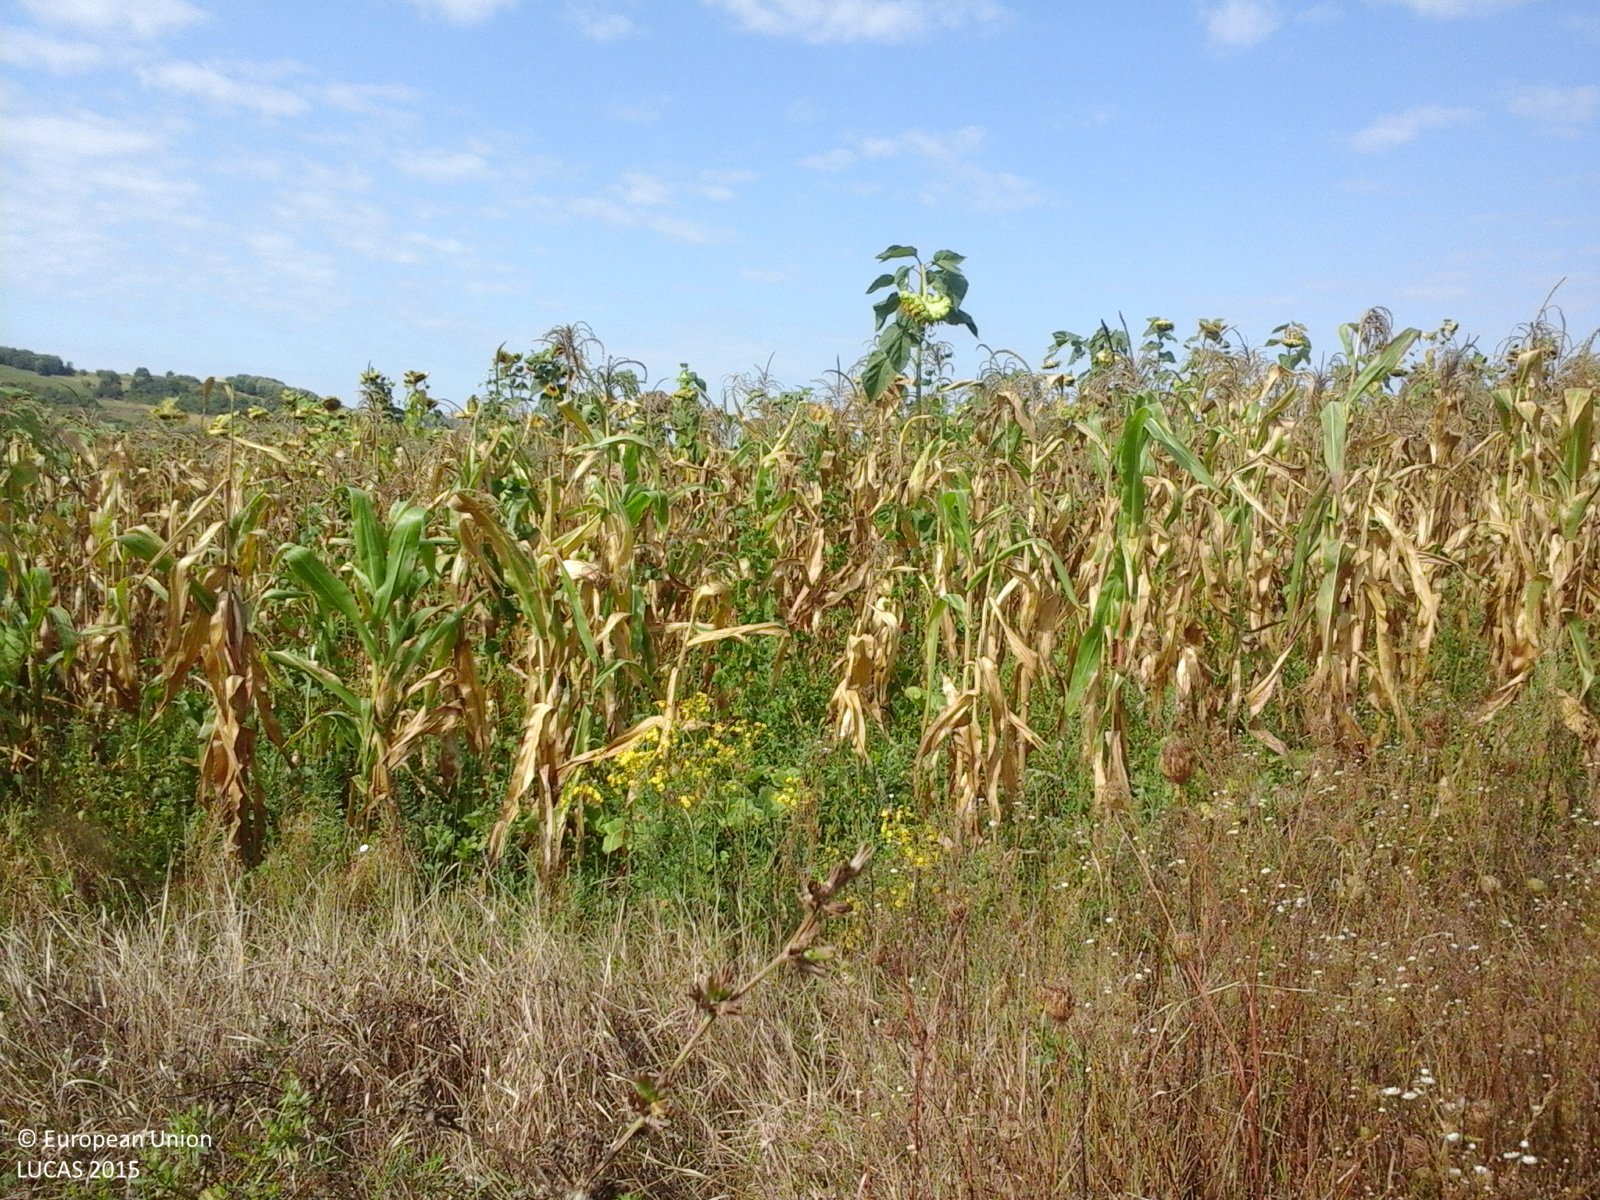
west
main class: Grassland
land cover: Spontaneously vegetated surfaces
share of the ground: > 75 %
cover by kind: herbaceous plants 100 %
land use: Fallow land
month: September
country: RO
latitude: 47.3574
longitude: 23.1608
